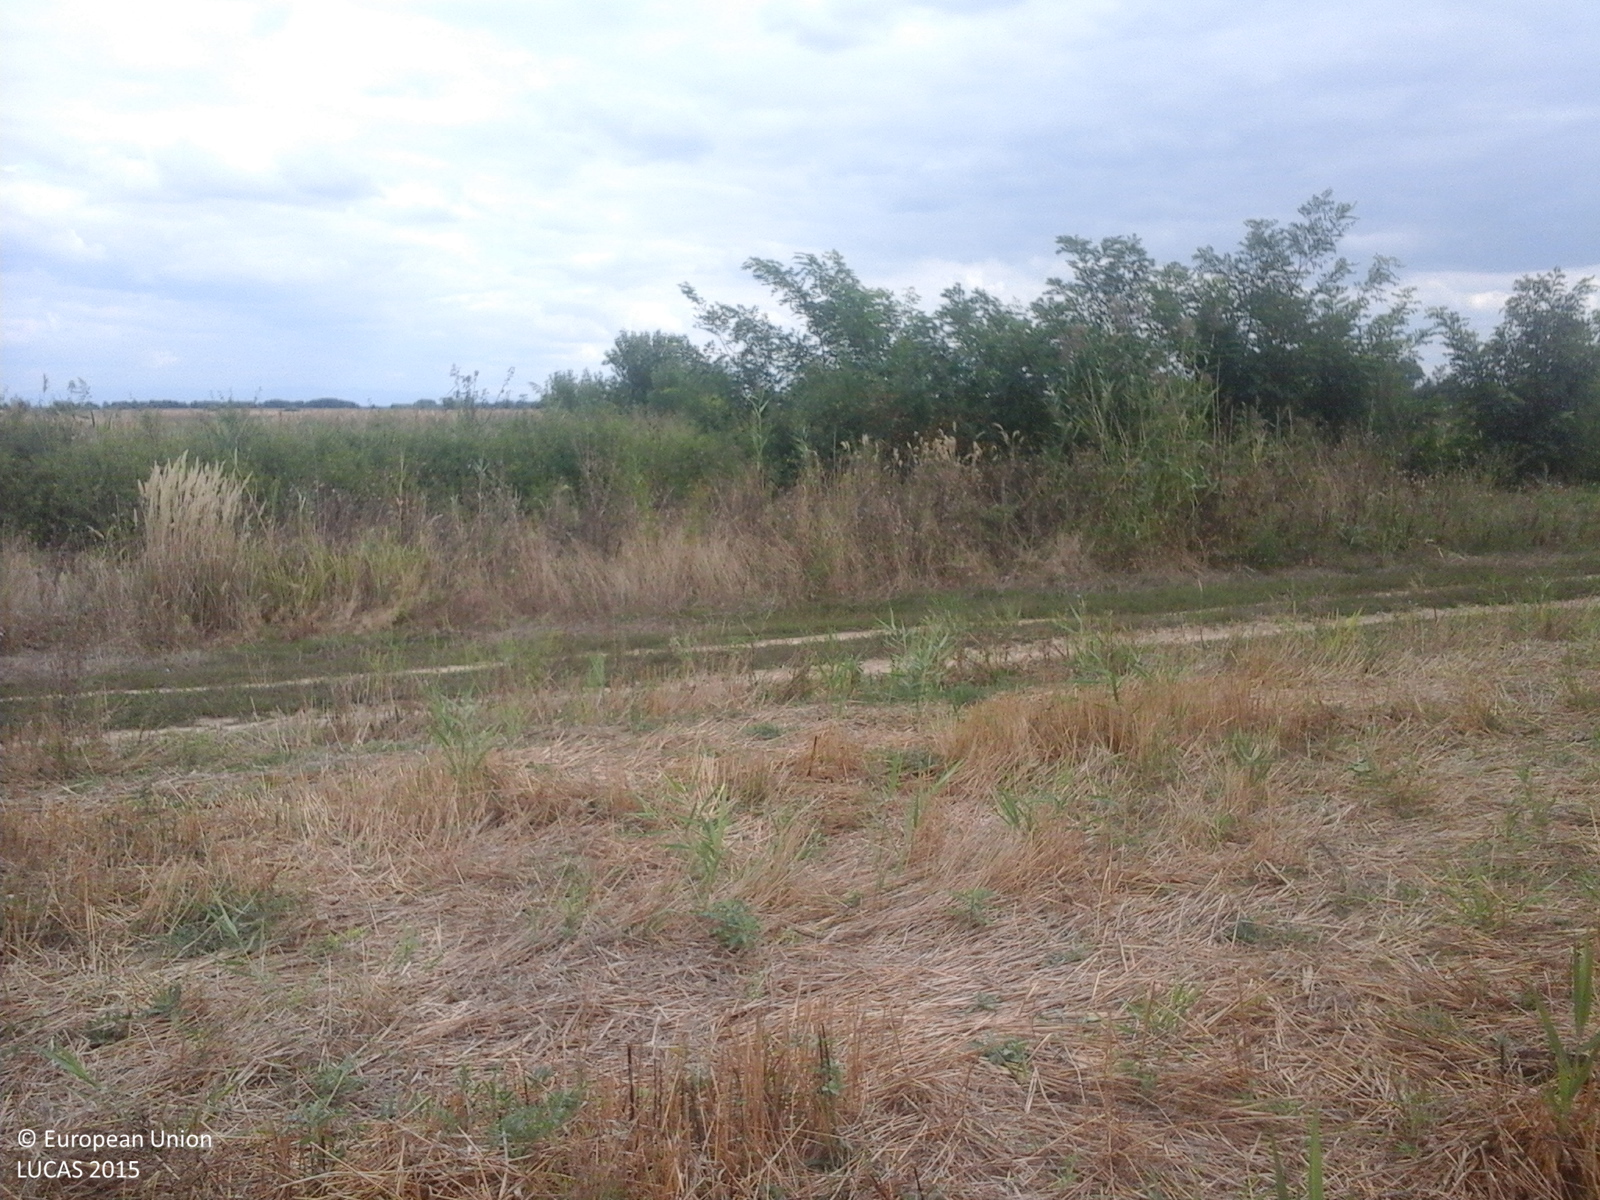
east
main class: Cropland
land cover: Common wheat
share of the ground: > 75 %
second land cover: Spontaneously vegetated surfaces
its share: 25 - 50 %
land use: Agriculture (excluding fallow land and kitchen gardens)
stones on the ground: < 10 %
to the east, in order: Common wheat; Spontaneously vegetated surfaces; Tracks; Grass margins; Shrubland without tree cover; Ditches and canals; Shrubland without tree cover; Spontaneously vegetated surfaces; Maize; Common wheat
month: September
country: RO
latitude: 47.8769
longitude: 22.7792
